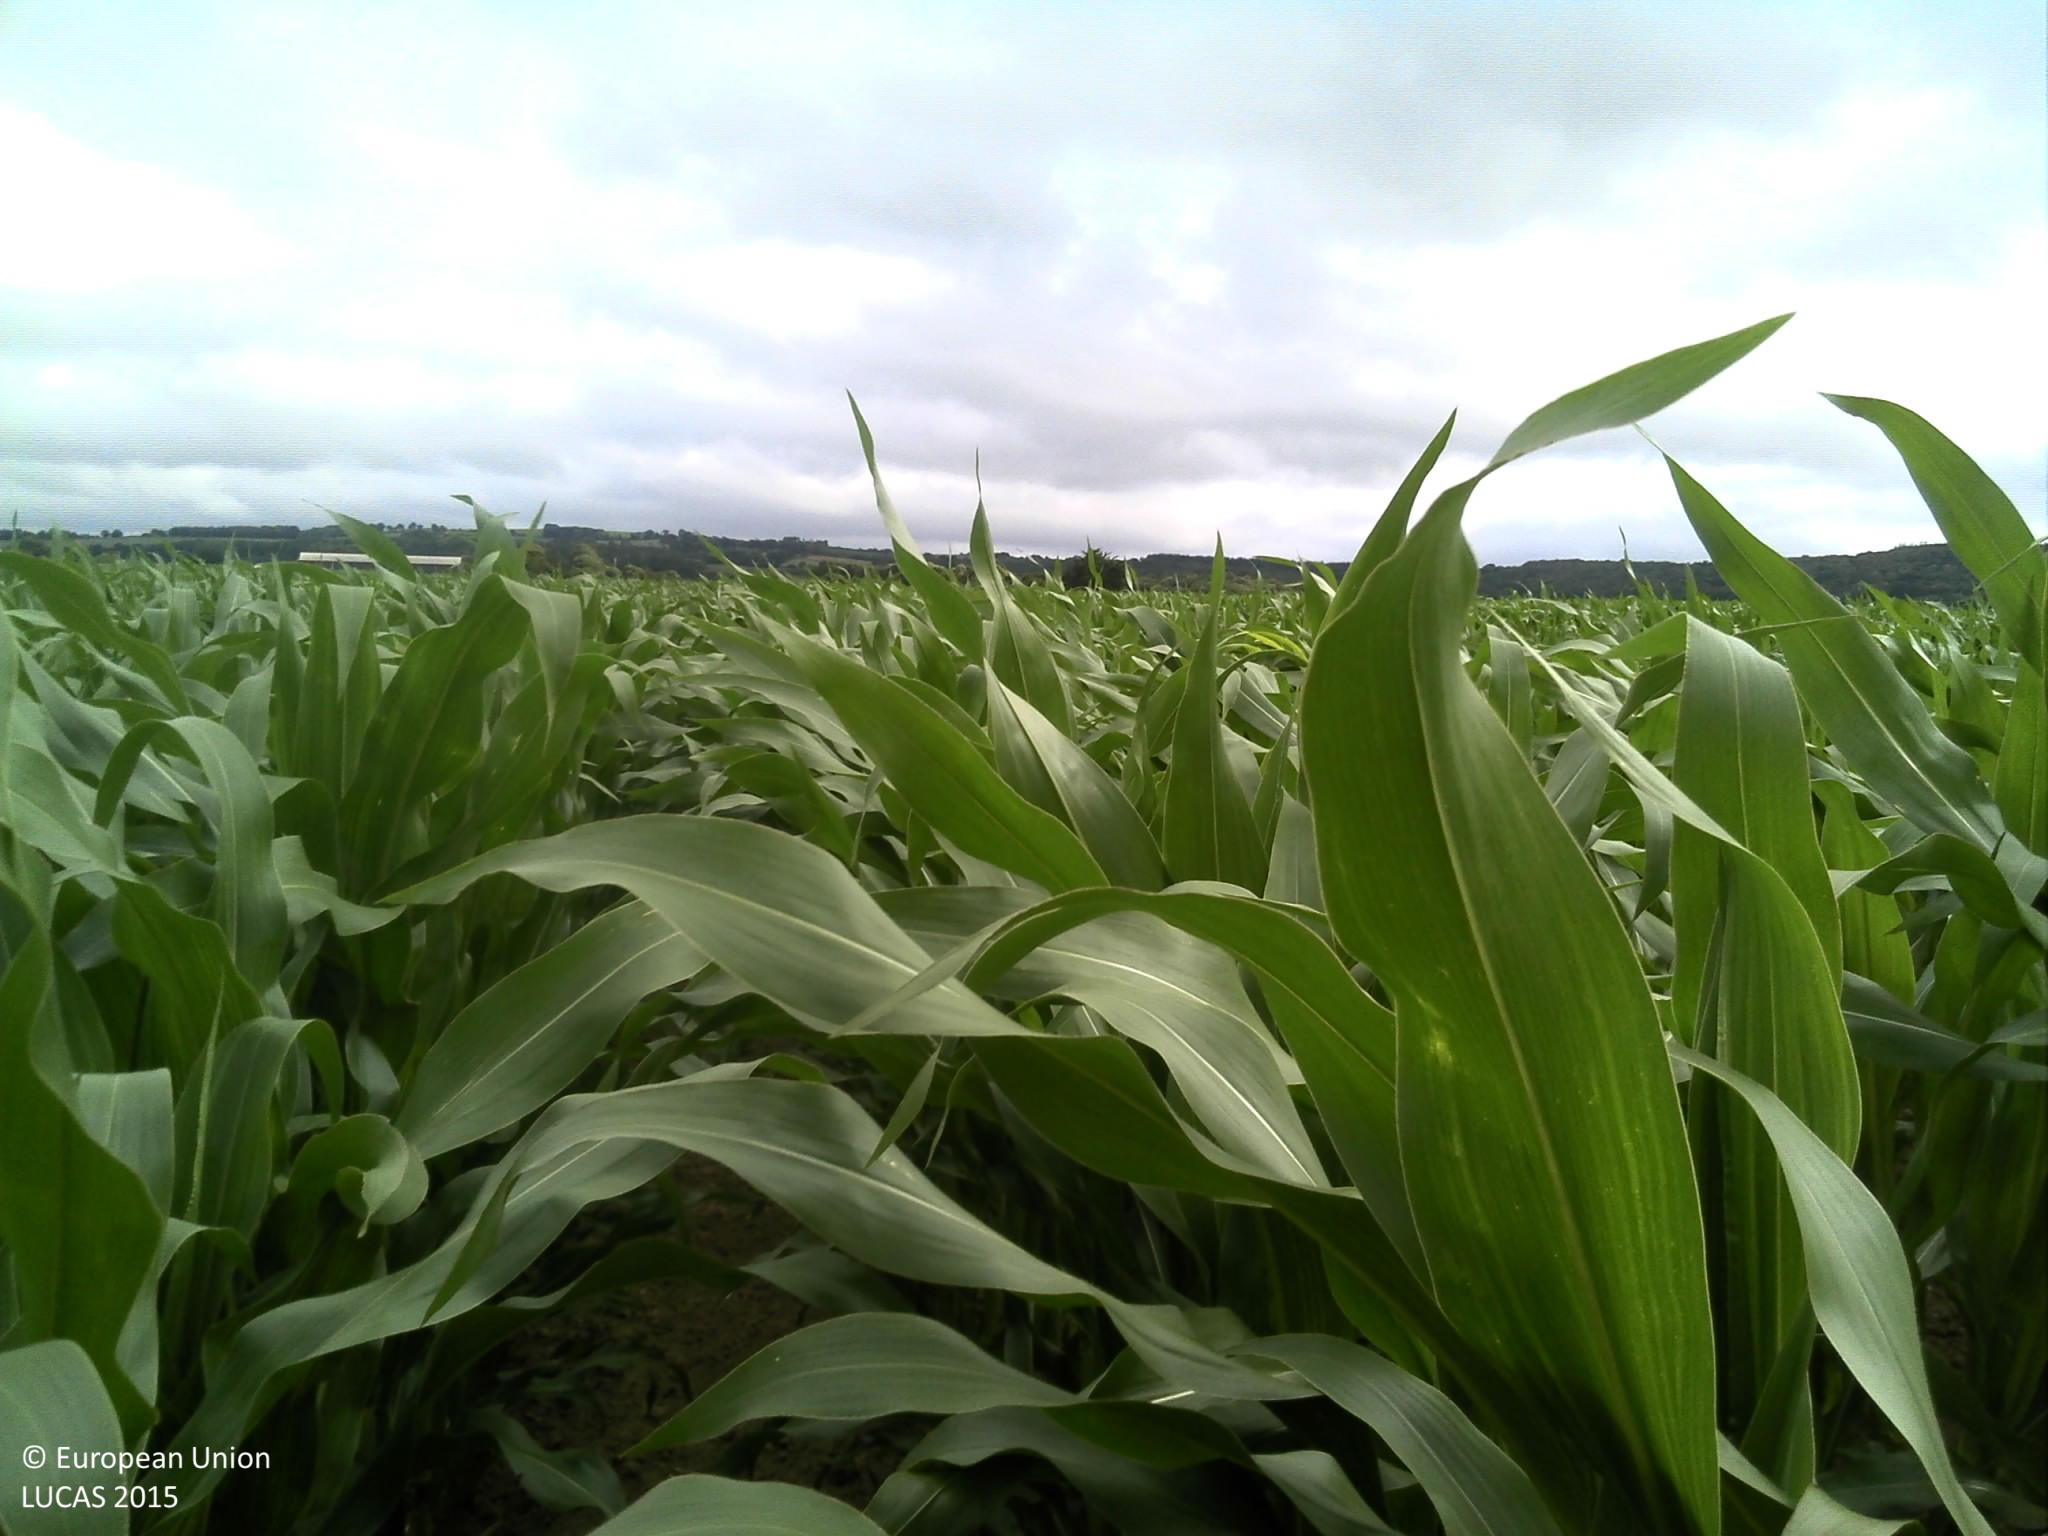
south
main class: Cropland
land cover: Maize
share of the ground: > 75 %
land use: Agriculture (excluding fallow land and kitchen gardens)
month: July
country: FR
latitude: 48.5110
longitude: -3.7145
